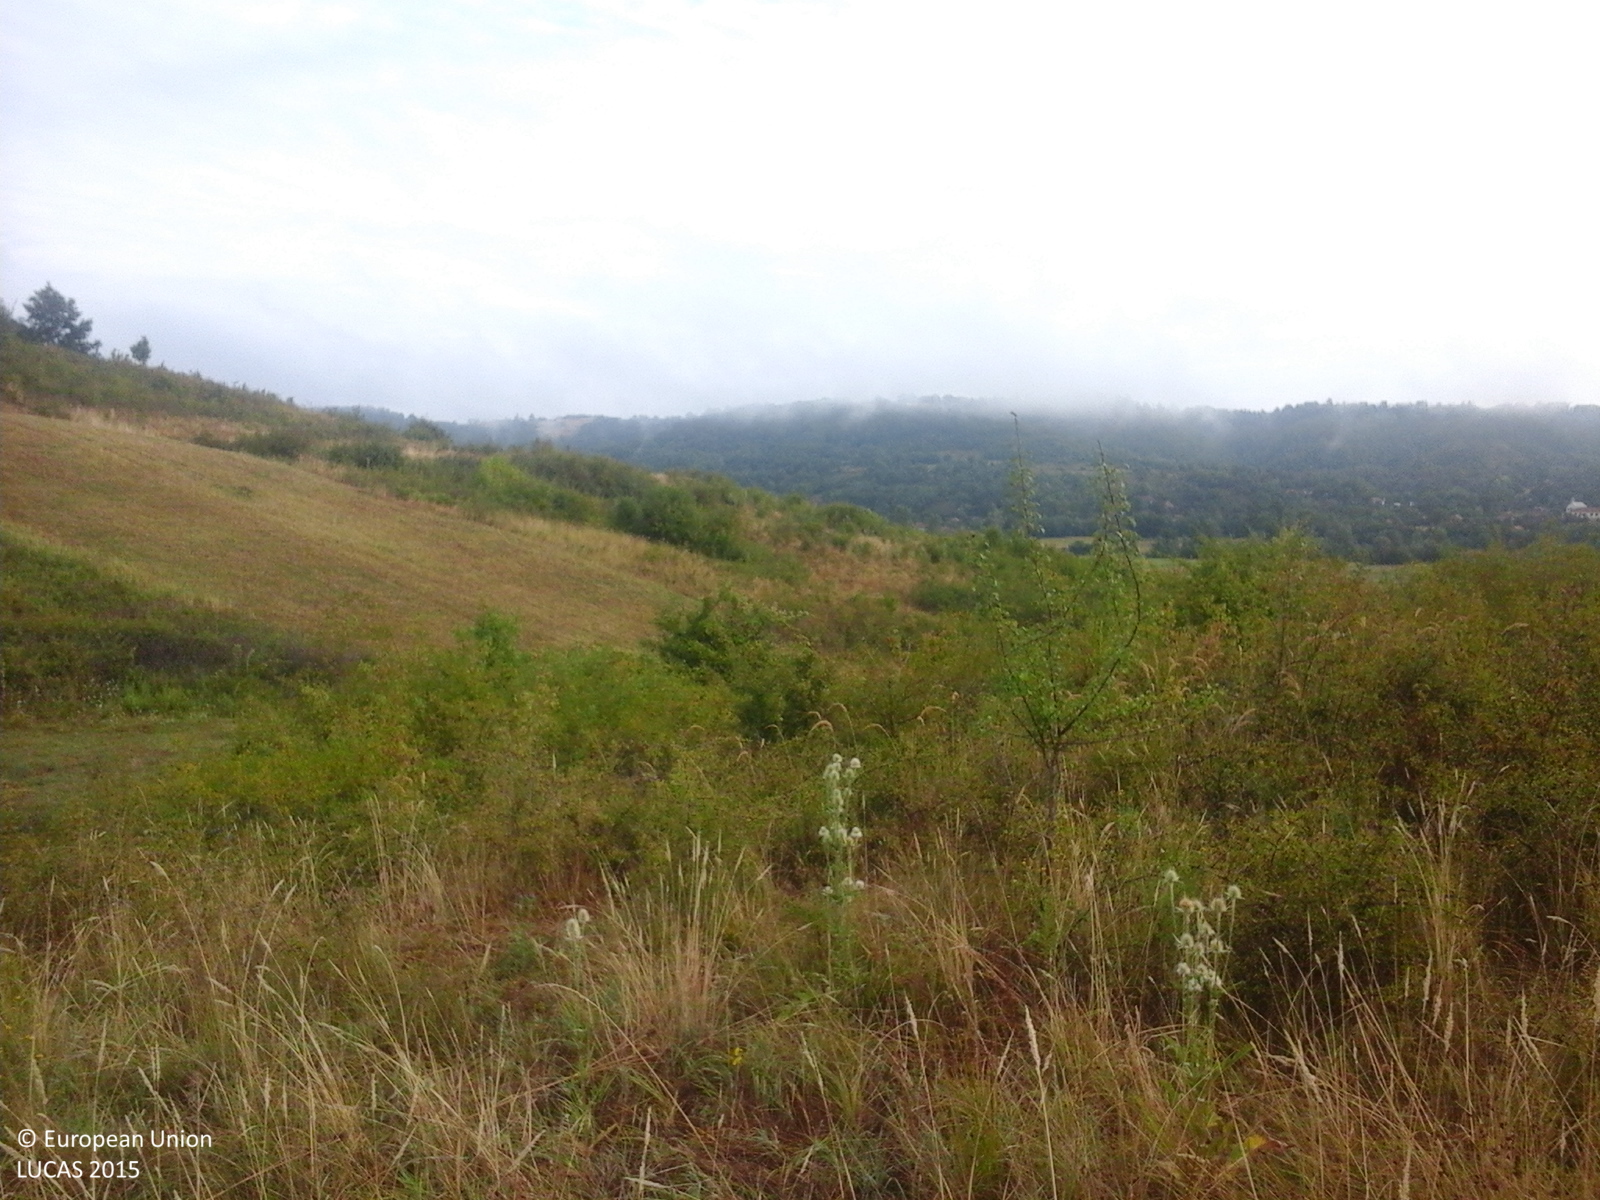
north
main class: Grassland
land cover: Grassland without tree/shrub cover
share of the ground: > 75 %
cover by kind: herbaceous plants 100 %
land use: Agriculture (excluding fallow land and kitchen gardens)
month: August
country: RO
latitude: 44.7738
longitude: 22.8202
